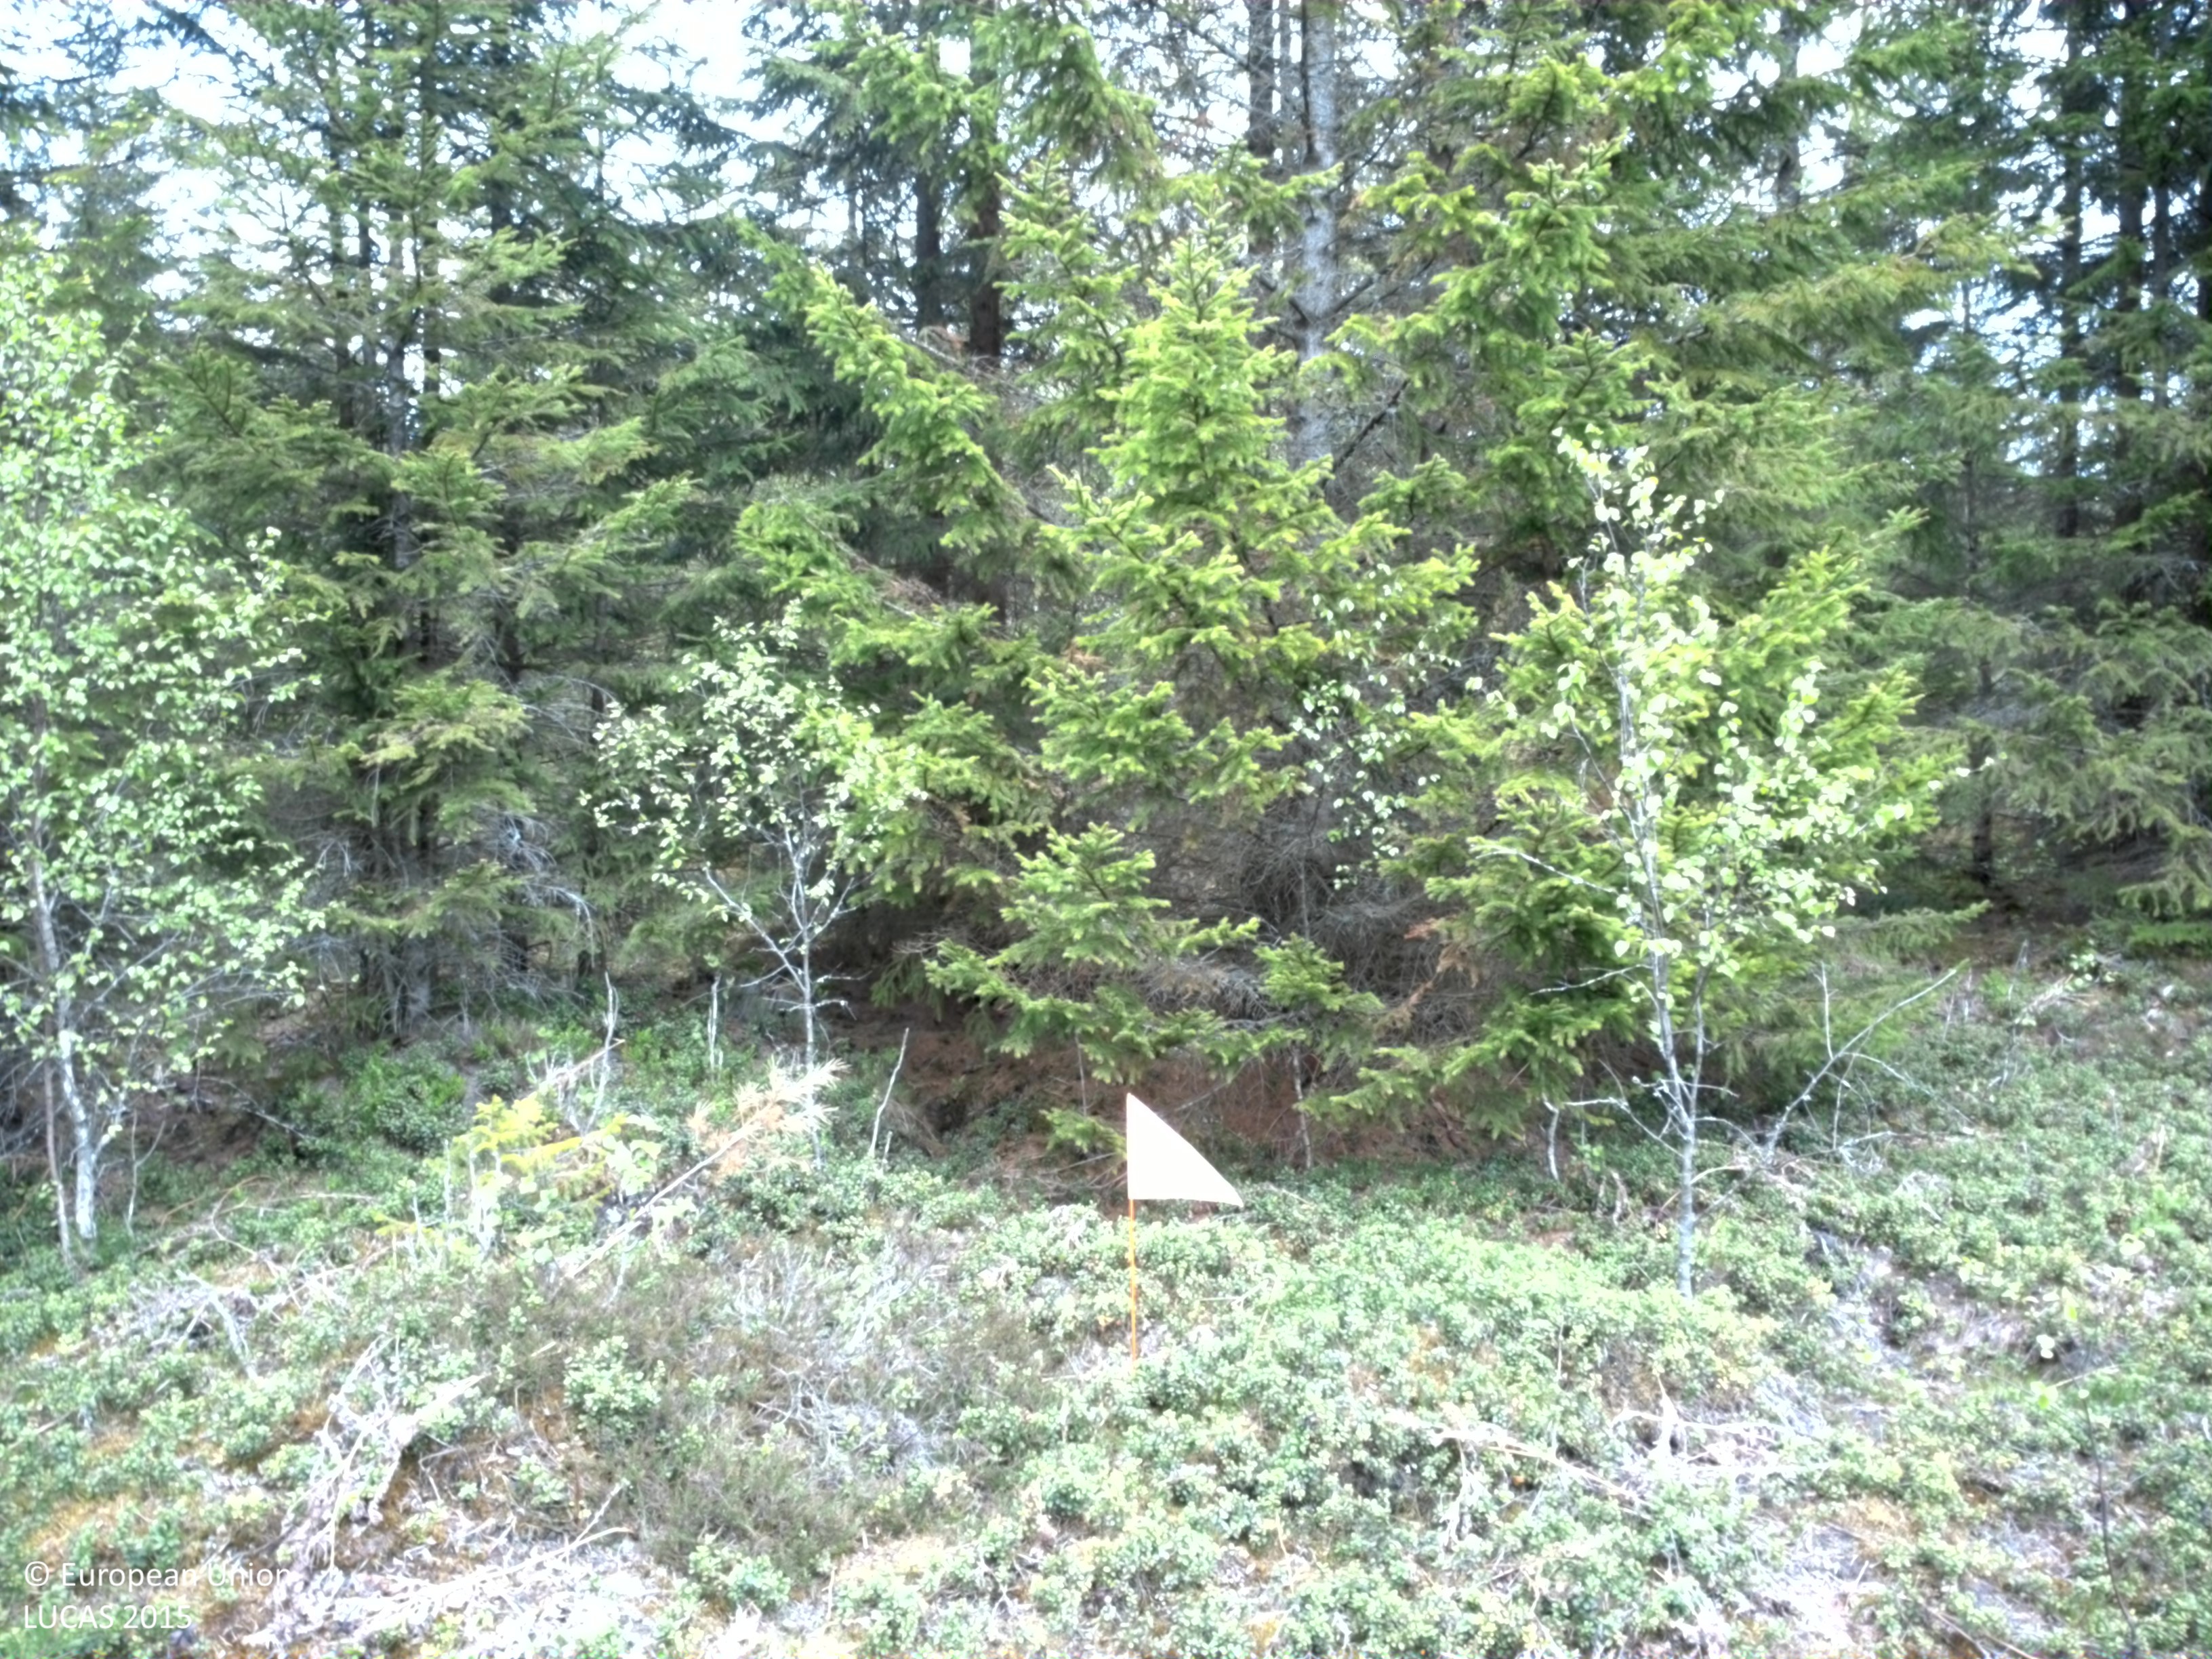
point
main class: Woodland
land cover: Spruce dominated coniferous woodland
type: boreal forest
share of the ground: 50 - 75 %
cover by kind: coniferous forest trees 50 %, shrubs 30 %, broadleaved forest trees 10 %, herbaceous plants 5 %, lichens and mosses 5 %
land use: Forestry
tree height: > 5 m
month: May
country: SE
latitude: 56.8933
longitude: 15.2014
